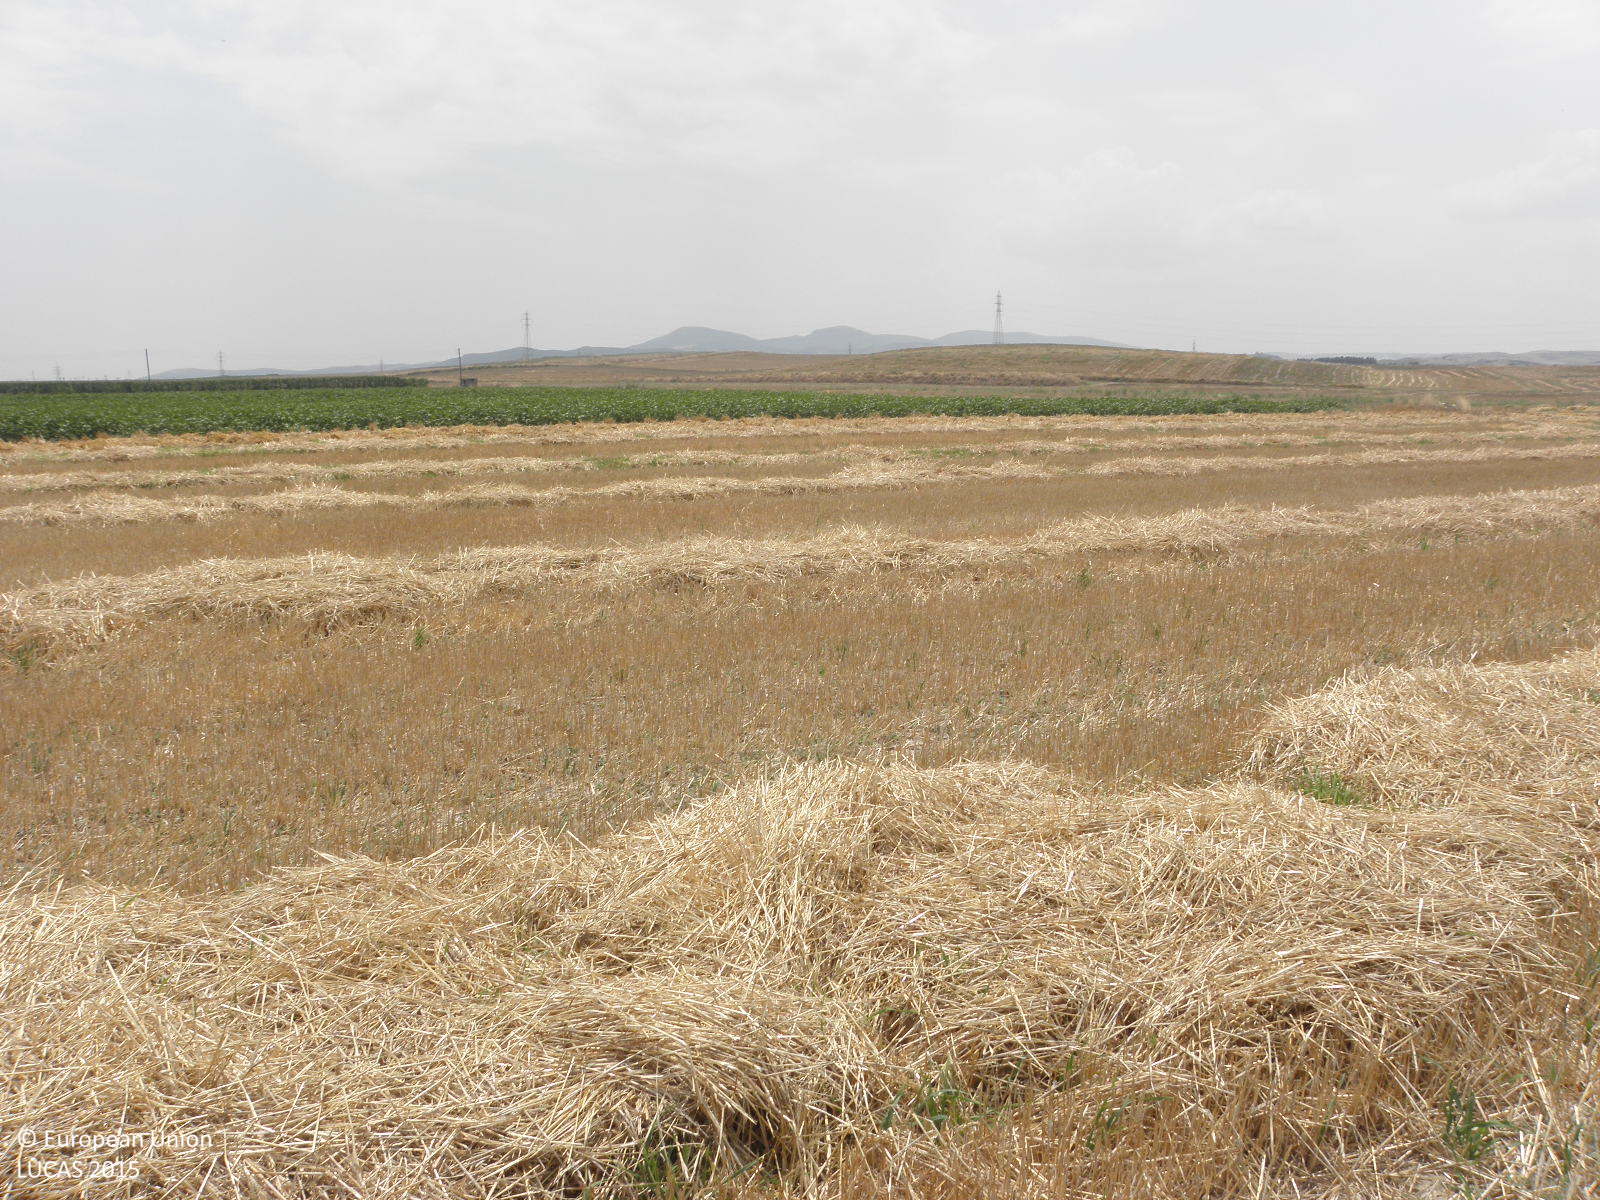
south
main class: Cropland
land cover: Durum wheat
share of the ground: > 75 %
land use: Agriculture (excluding fallow land and kitchen gardens)
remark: Harvested field
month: July
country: GR
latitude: 39.4576
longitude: 22.6929
